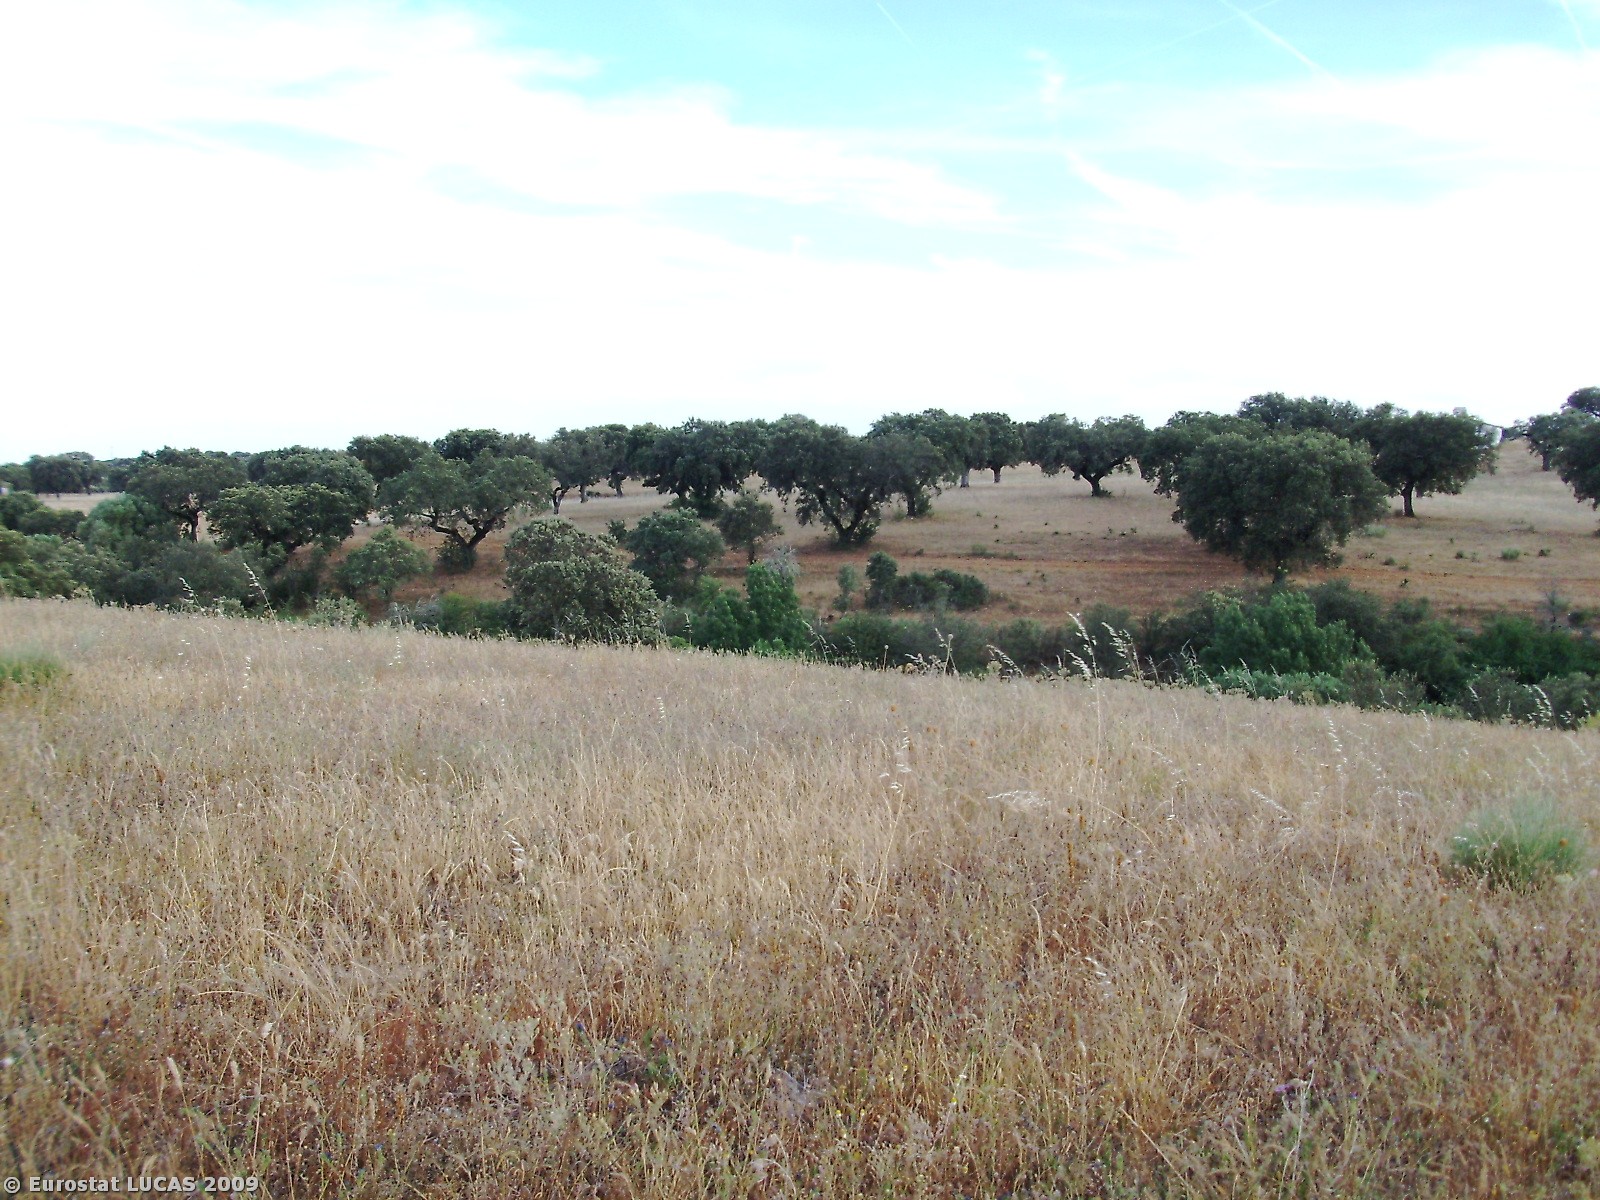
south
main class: Grassland
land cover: Spontaneously vegetated surfaces
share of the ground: > 75 %
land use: Fallow land
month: June
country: PT
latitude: 39.1401
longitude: -7.3092
